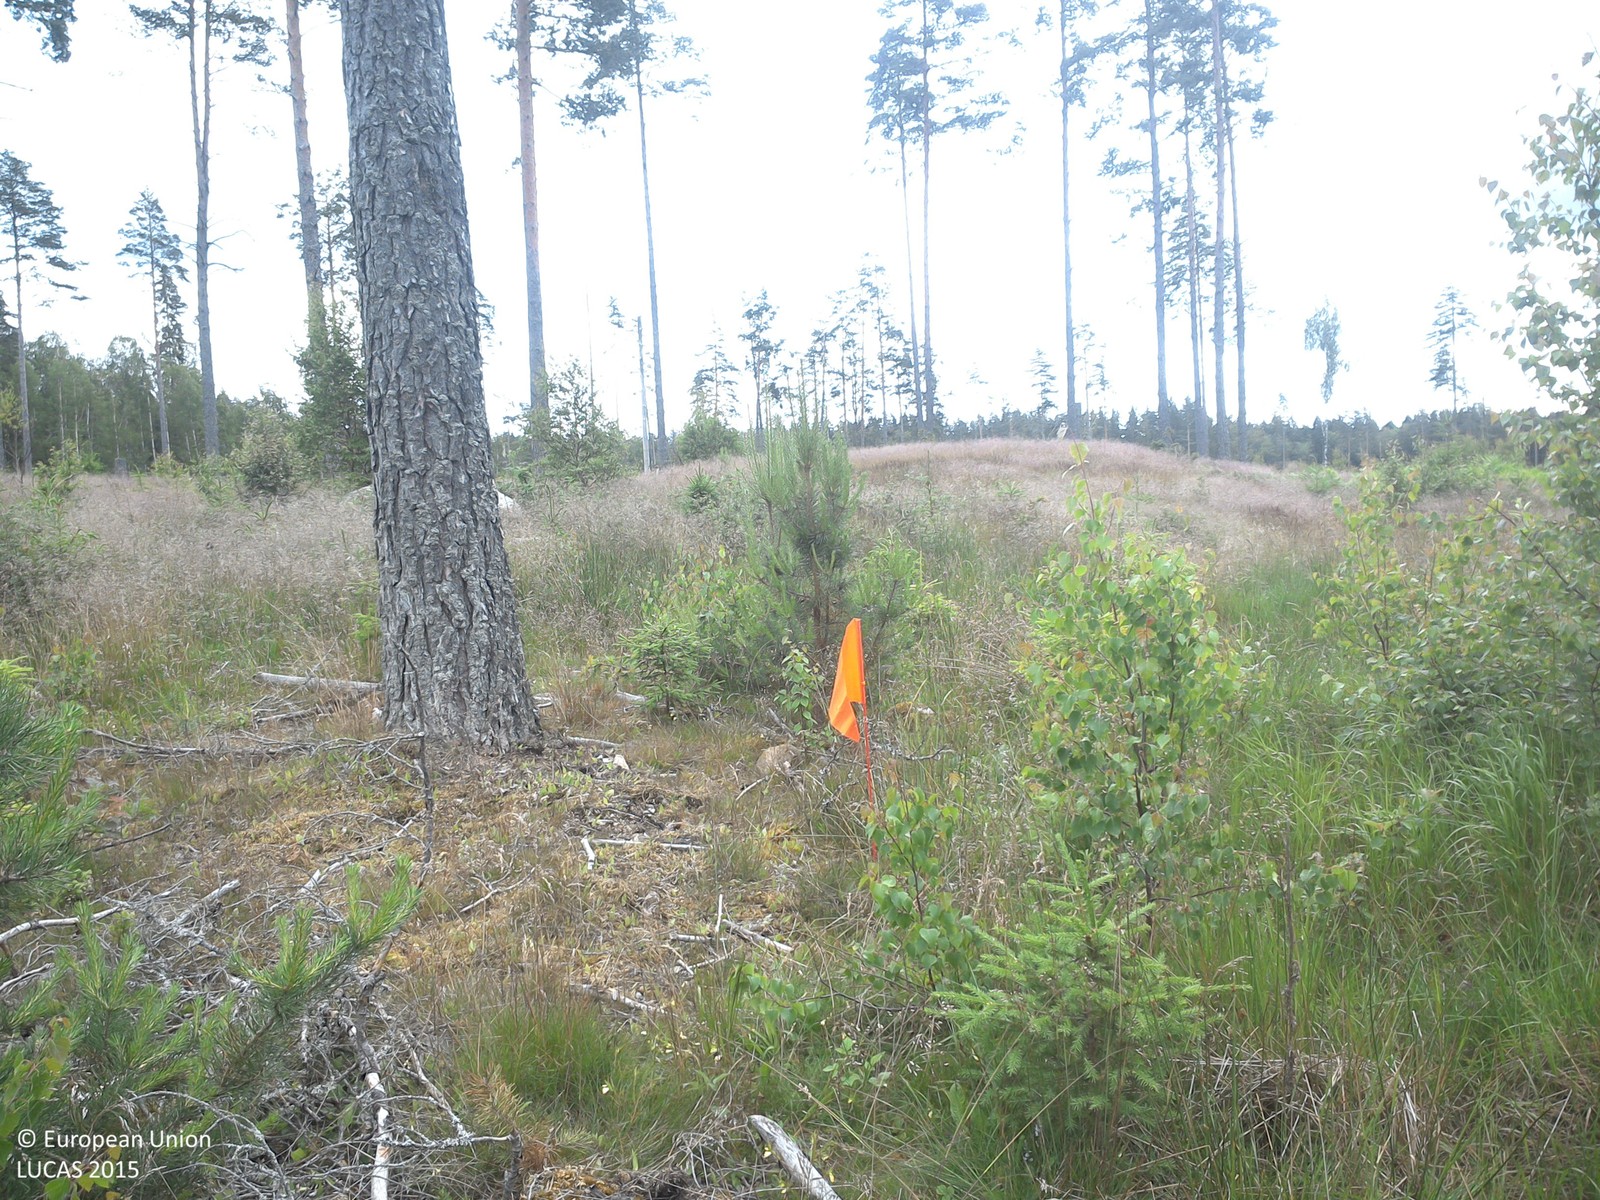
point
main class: Grassland
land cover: Grassland with sparse tree/shrub cover
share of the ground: < 10 %
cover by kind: herbaceous plants 70 %, lichens and mosses 15 %, shrubs 10 %, broadleaved forest trees 5 %
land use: Forestry
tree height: > 5 m
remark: Clear cut
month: June
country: SE
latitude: 58.2830
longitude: 15.6057
